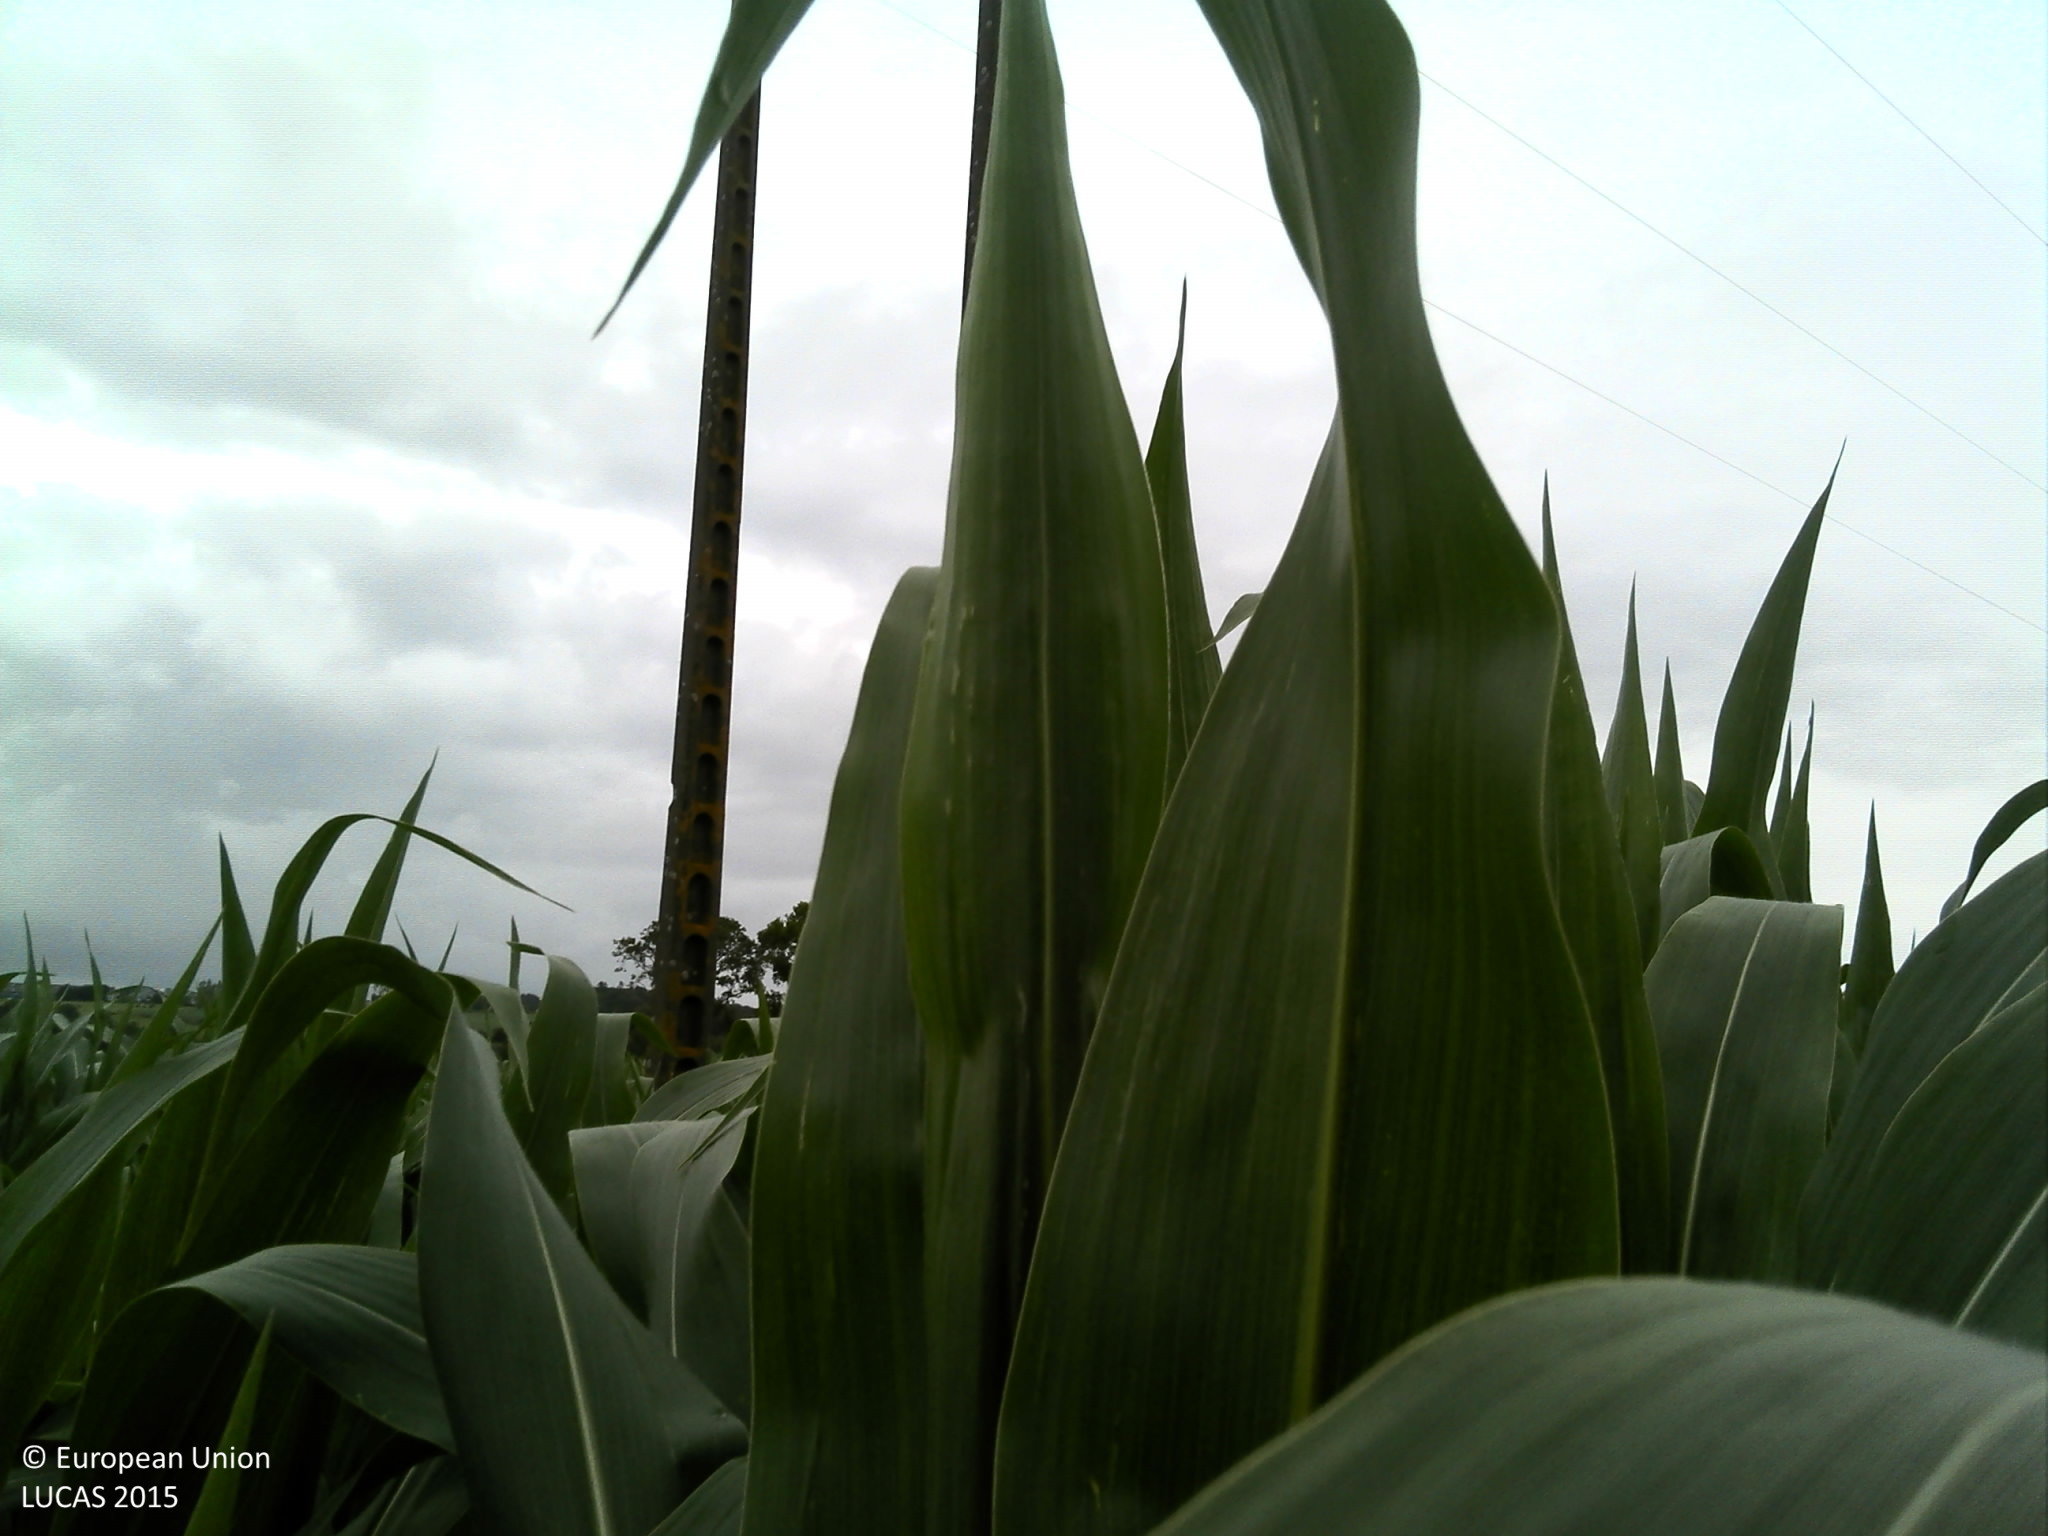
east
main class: Cropland
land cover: Maize
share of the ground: > 75 %
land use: Agriculture (excluding fallow land and kitchen gardens)
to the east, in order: Maize; Electric lines; Maize; Managed hedges; Grass margins; Electric lines; Ditches and canals; Grass margins; Paved roads, cycling and walking lanes; Grass margins; Ditches and canals; Broadleaved woodland; Other fresh vegetables; Artificial constructions in urban areas
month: July
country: FR
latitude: 48.4500
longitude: -4.1942
